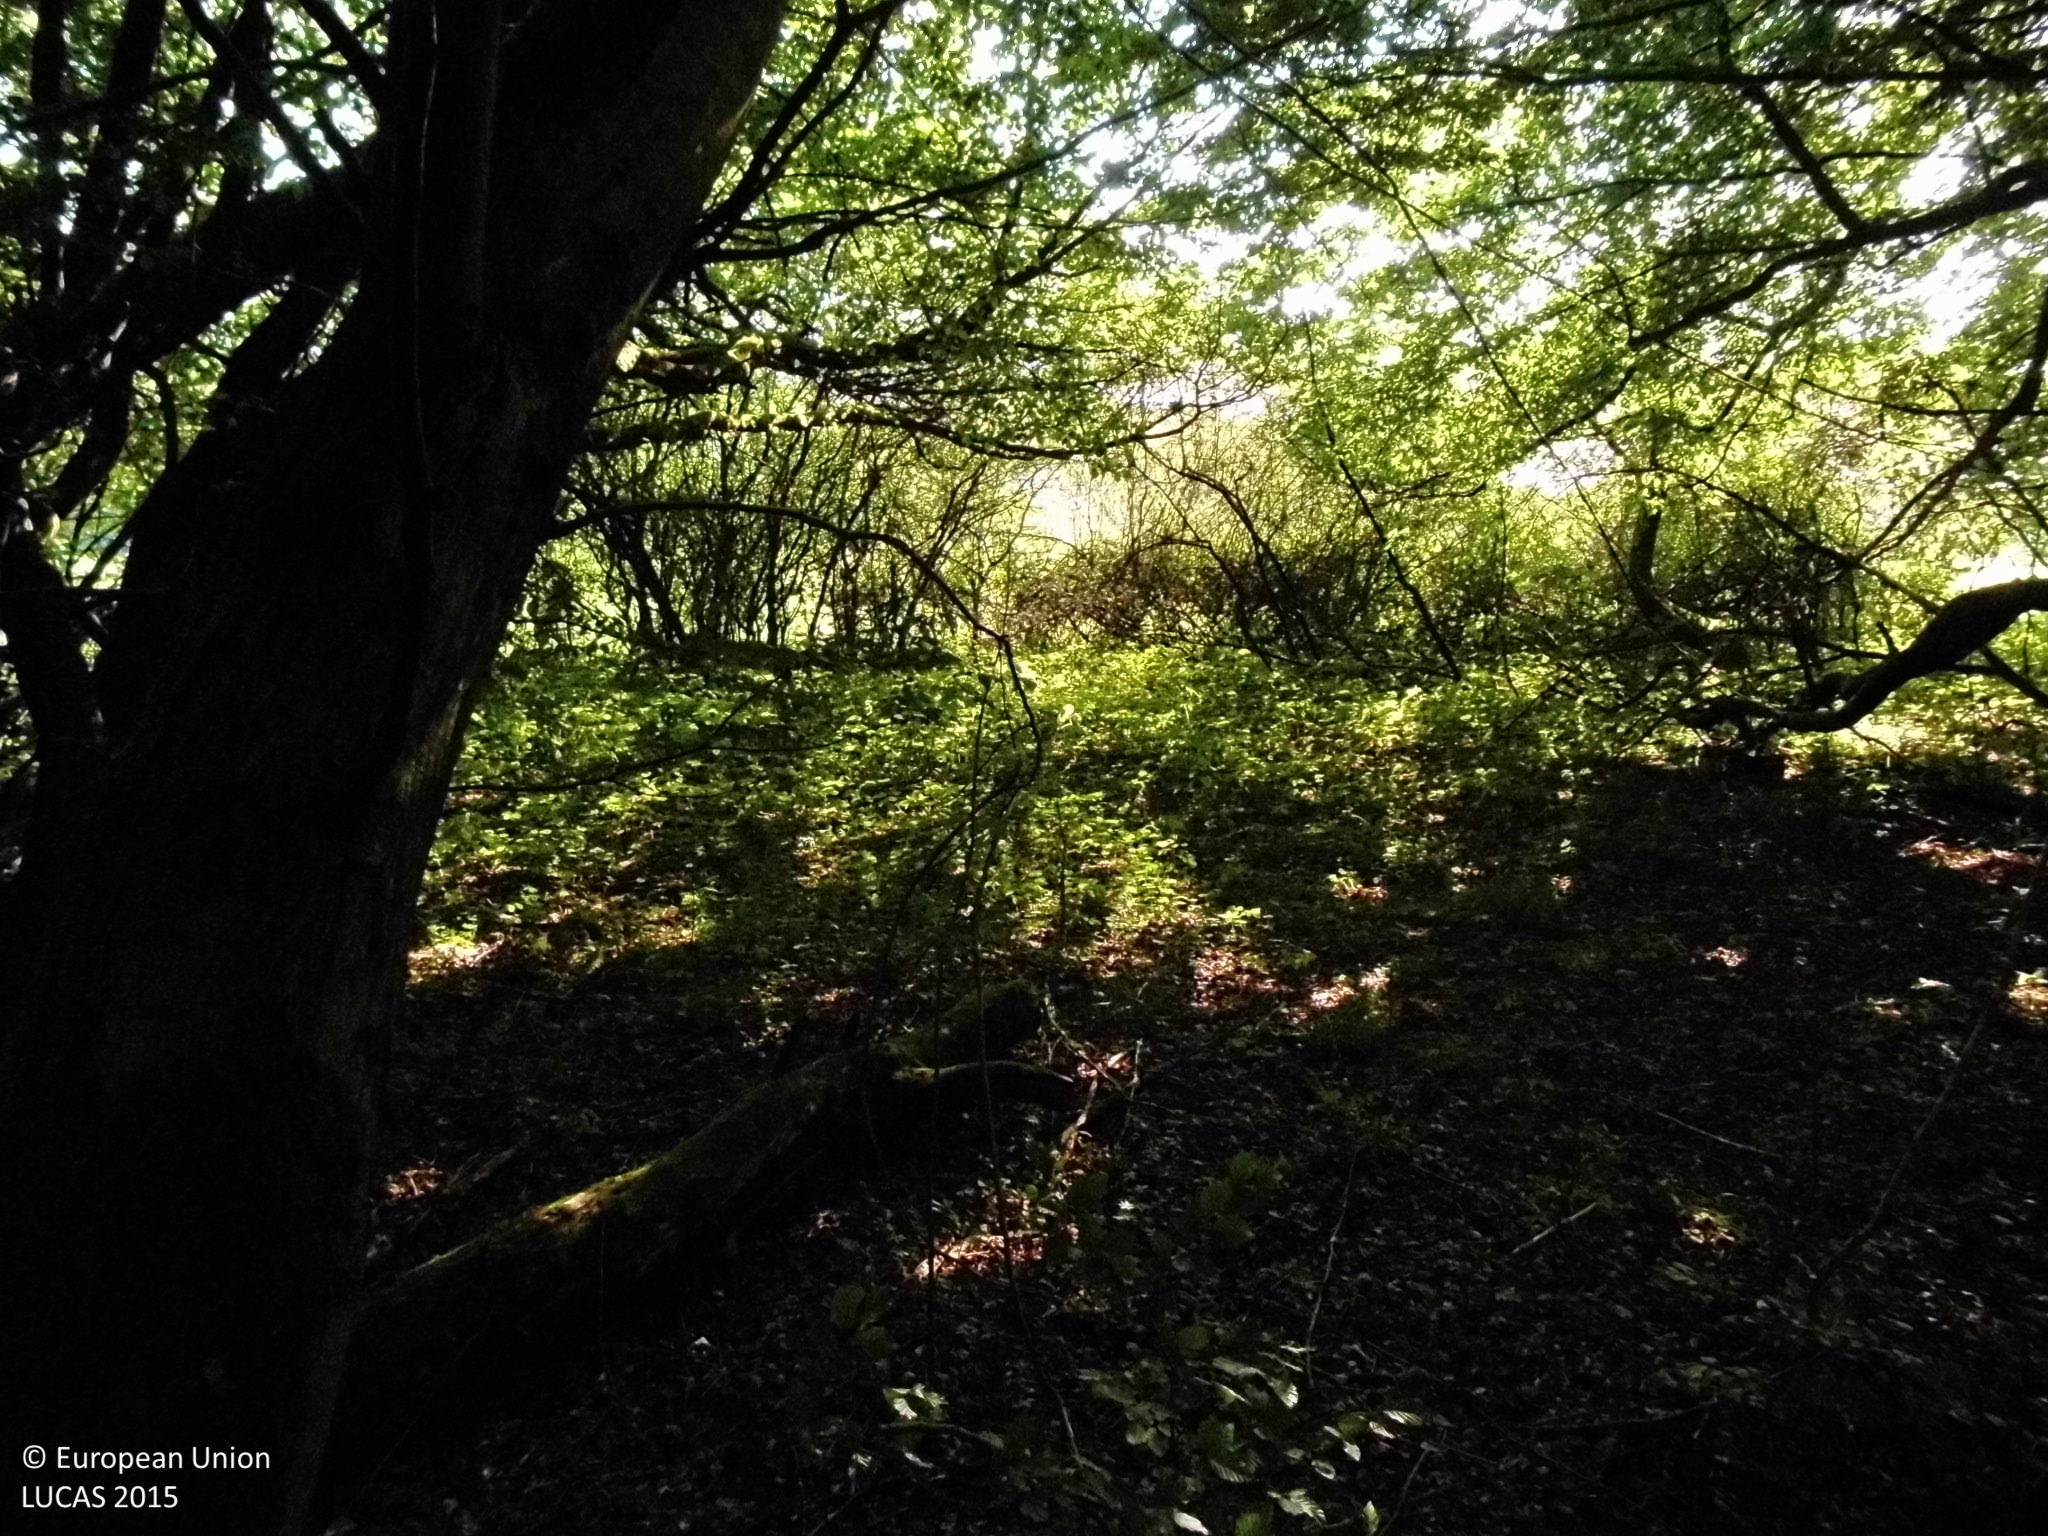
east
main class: Woodland
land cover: Broadleaved woodland
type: mesophytic deciduous forest
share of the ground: > 75 %
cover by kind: broadleaved forest trees 100 %
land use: Forestry
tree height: > 5 m
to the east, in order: Broadleaved woodland; Grassland without tree/shrub cover
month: August
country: DE
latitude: 50.5985
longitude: 8.0083
